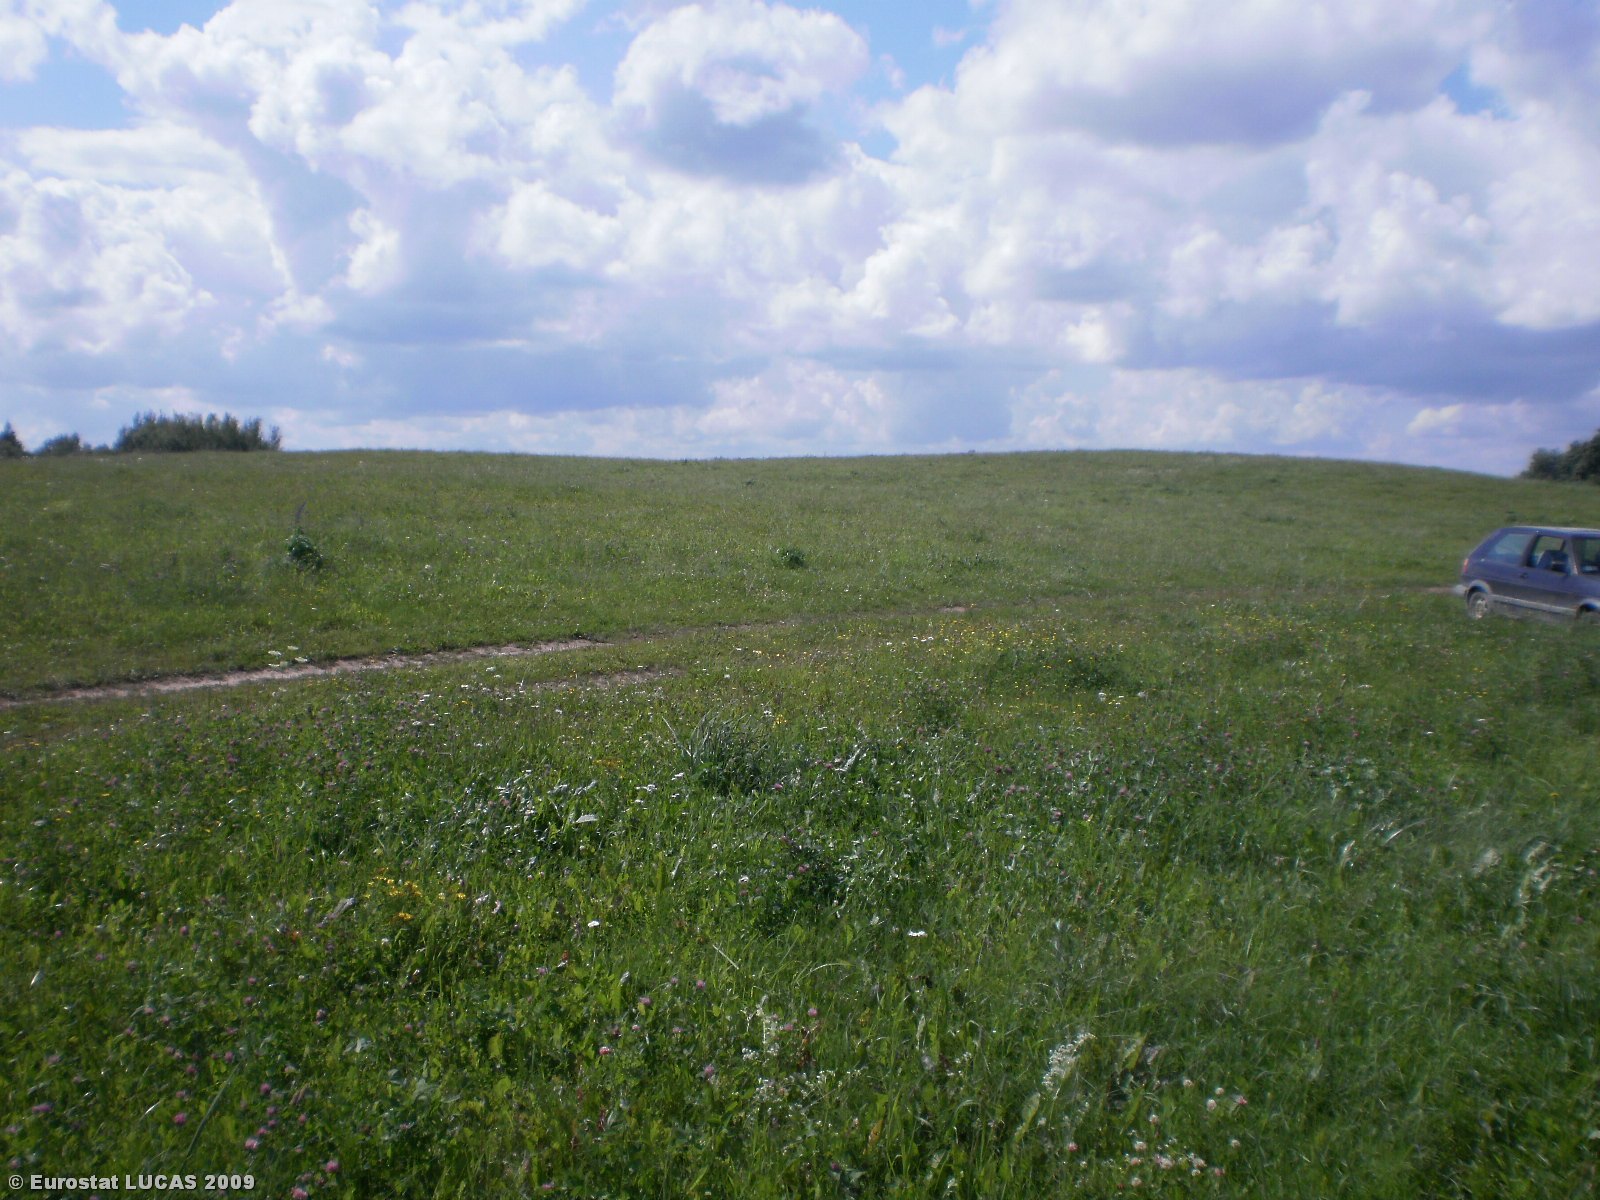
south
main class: Grassland
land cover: Grassland without tree/shrub cover
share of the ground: > 75 %
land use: Agriculture (excluding fallow land and kitchen gardens)
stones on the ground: 10 - 25 %
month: July
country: LT
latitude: 55.9710
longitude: 25.6525
